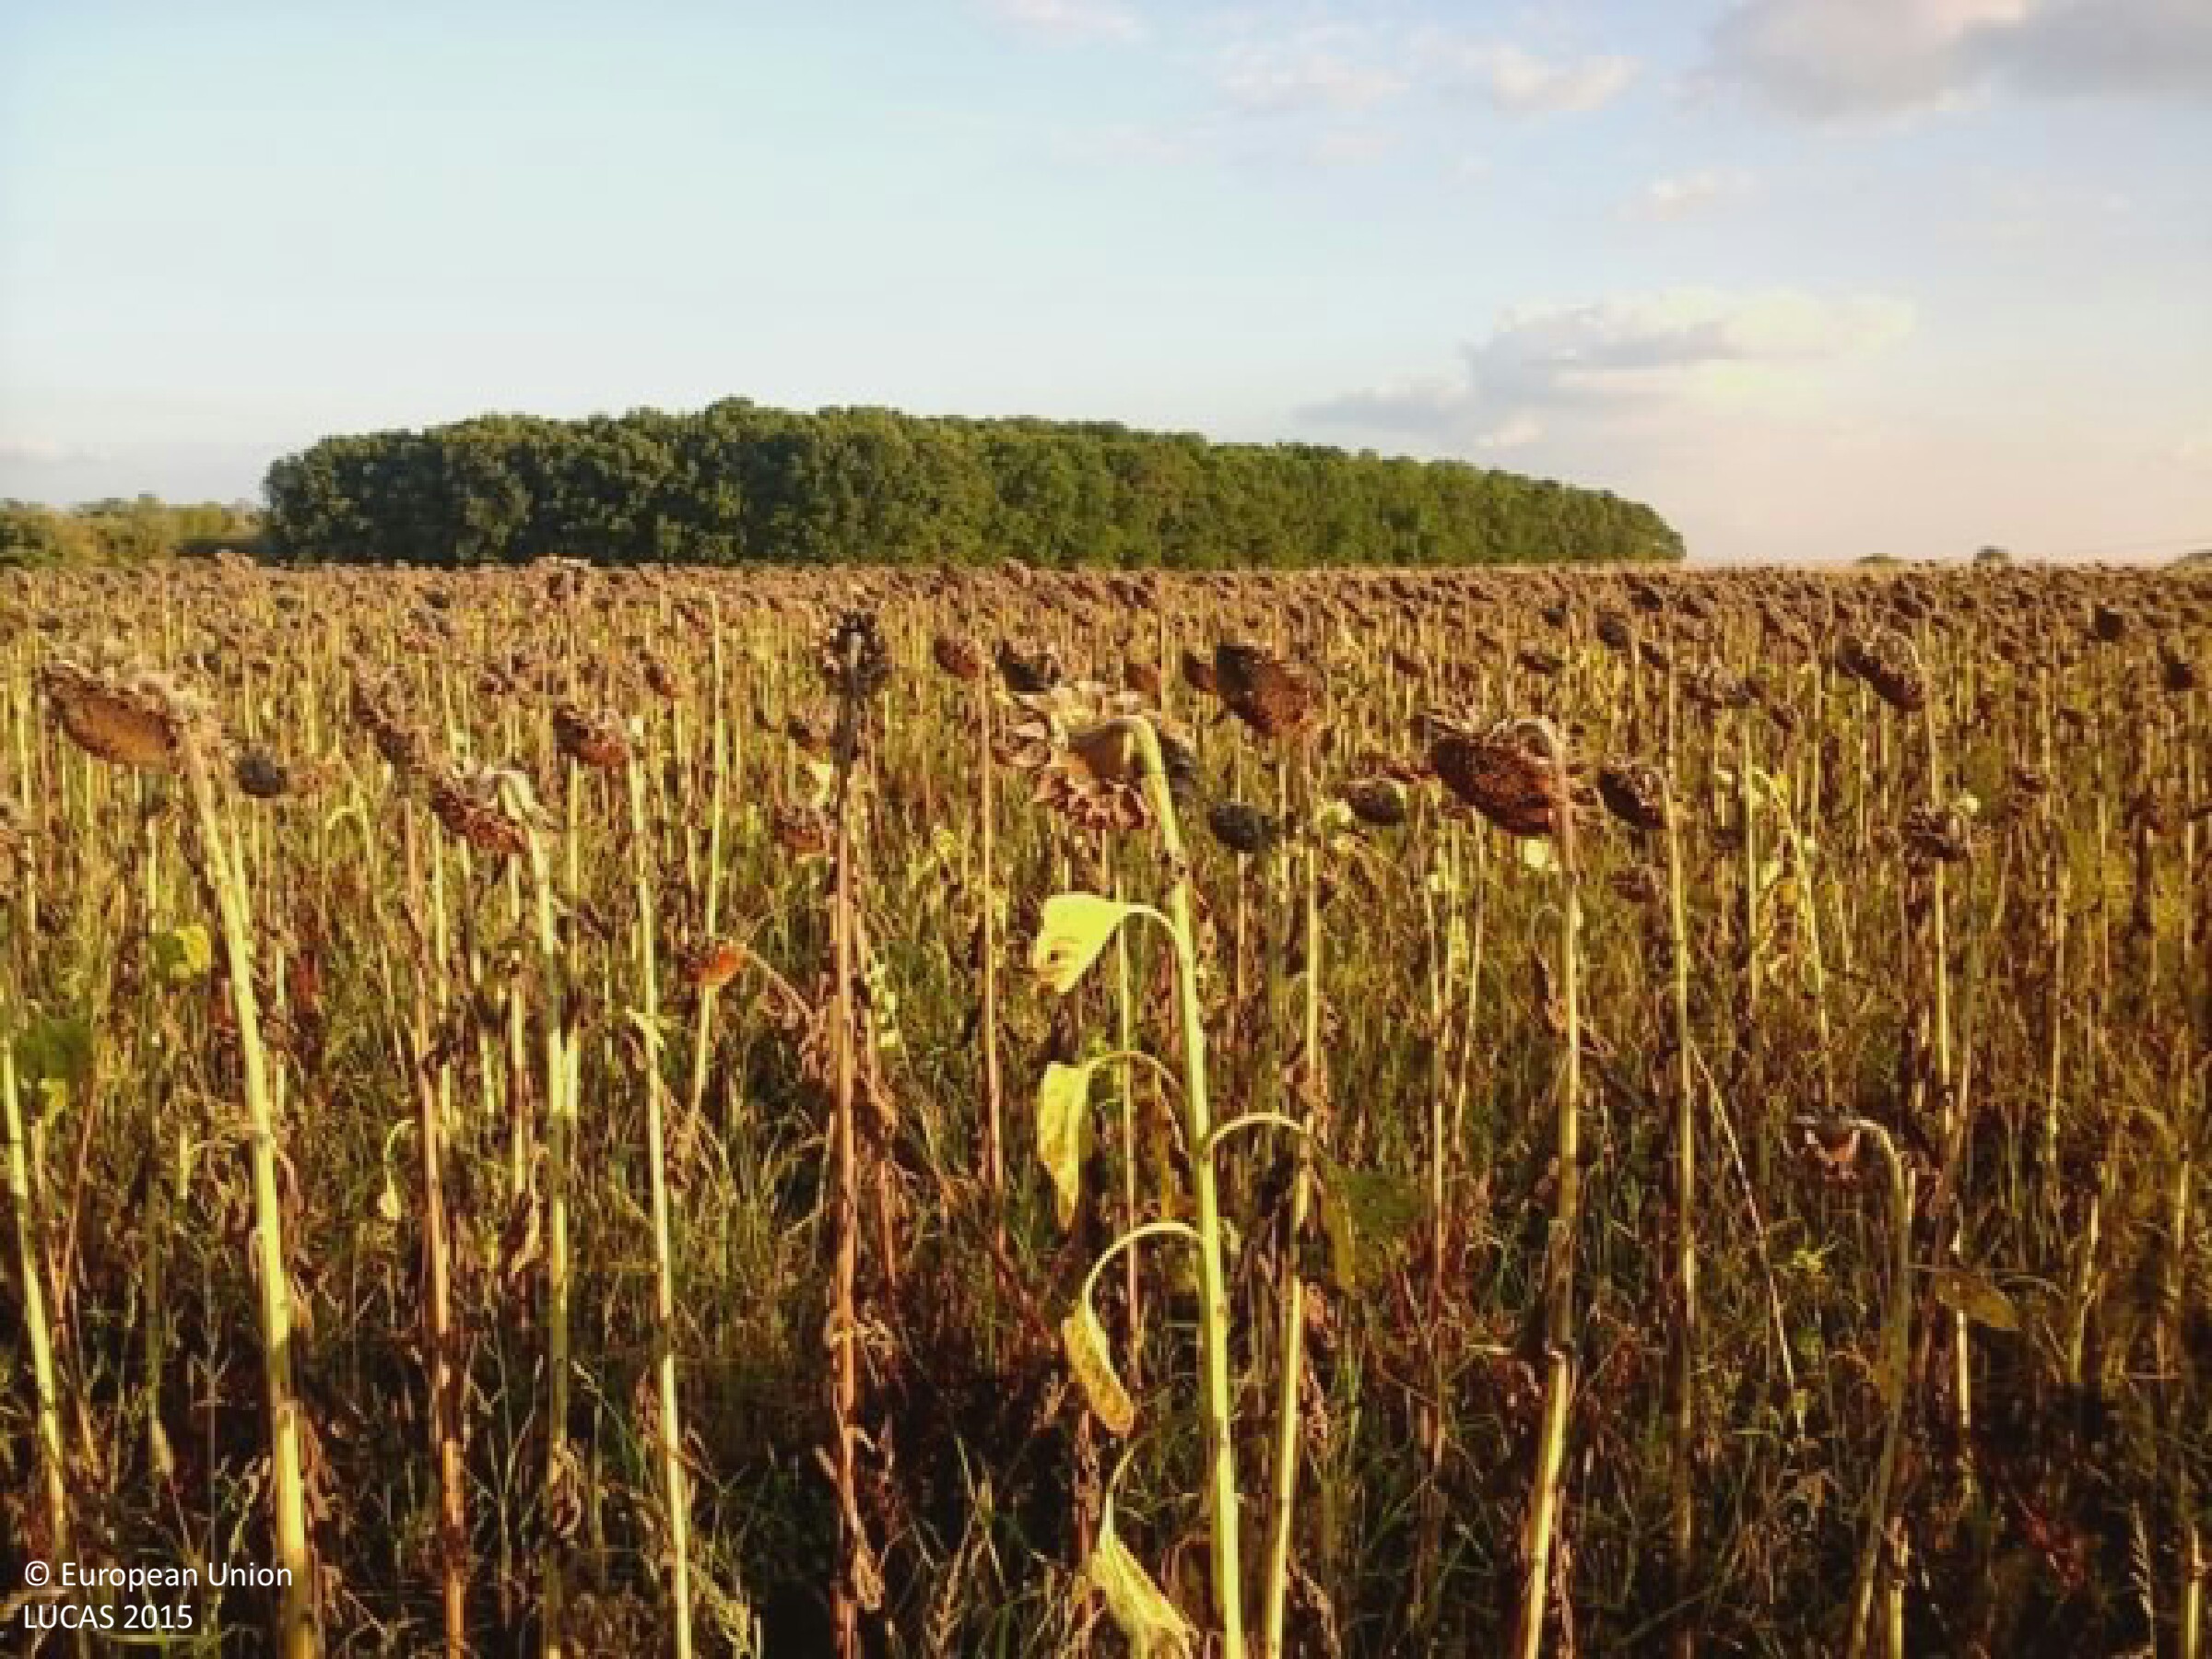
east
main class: Cropland
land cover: Sunflower
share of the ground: > 75 %
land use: Agriculture (excluding fallow land and kitchen gardens)
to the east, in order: Sunflower; Tracks; Shrubland without tree cover; Grassland without tree/shrub cover; Sunflower
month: September
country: HU
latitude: 47.7197
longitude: 19.9309
